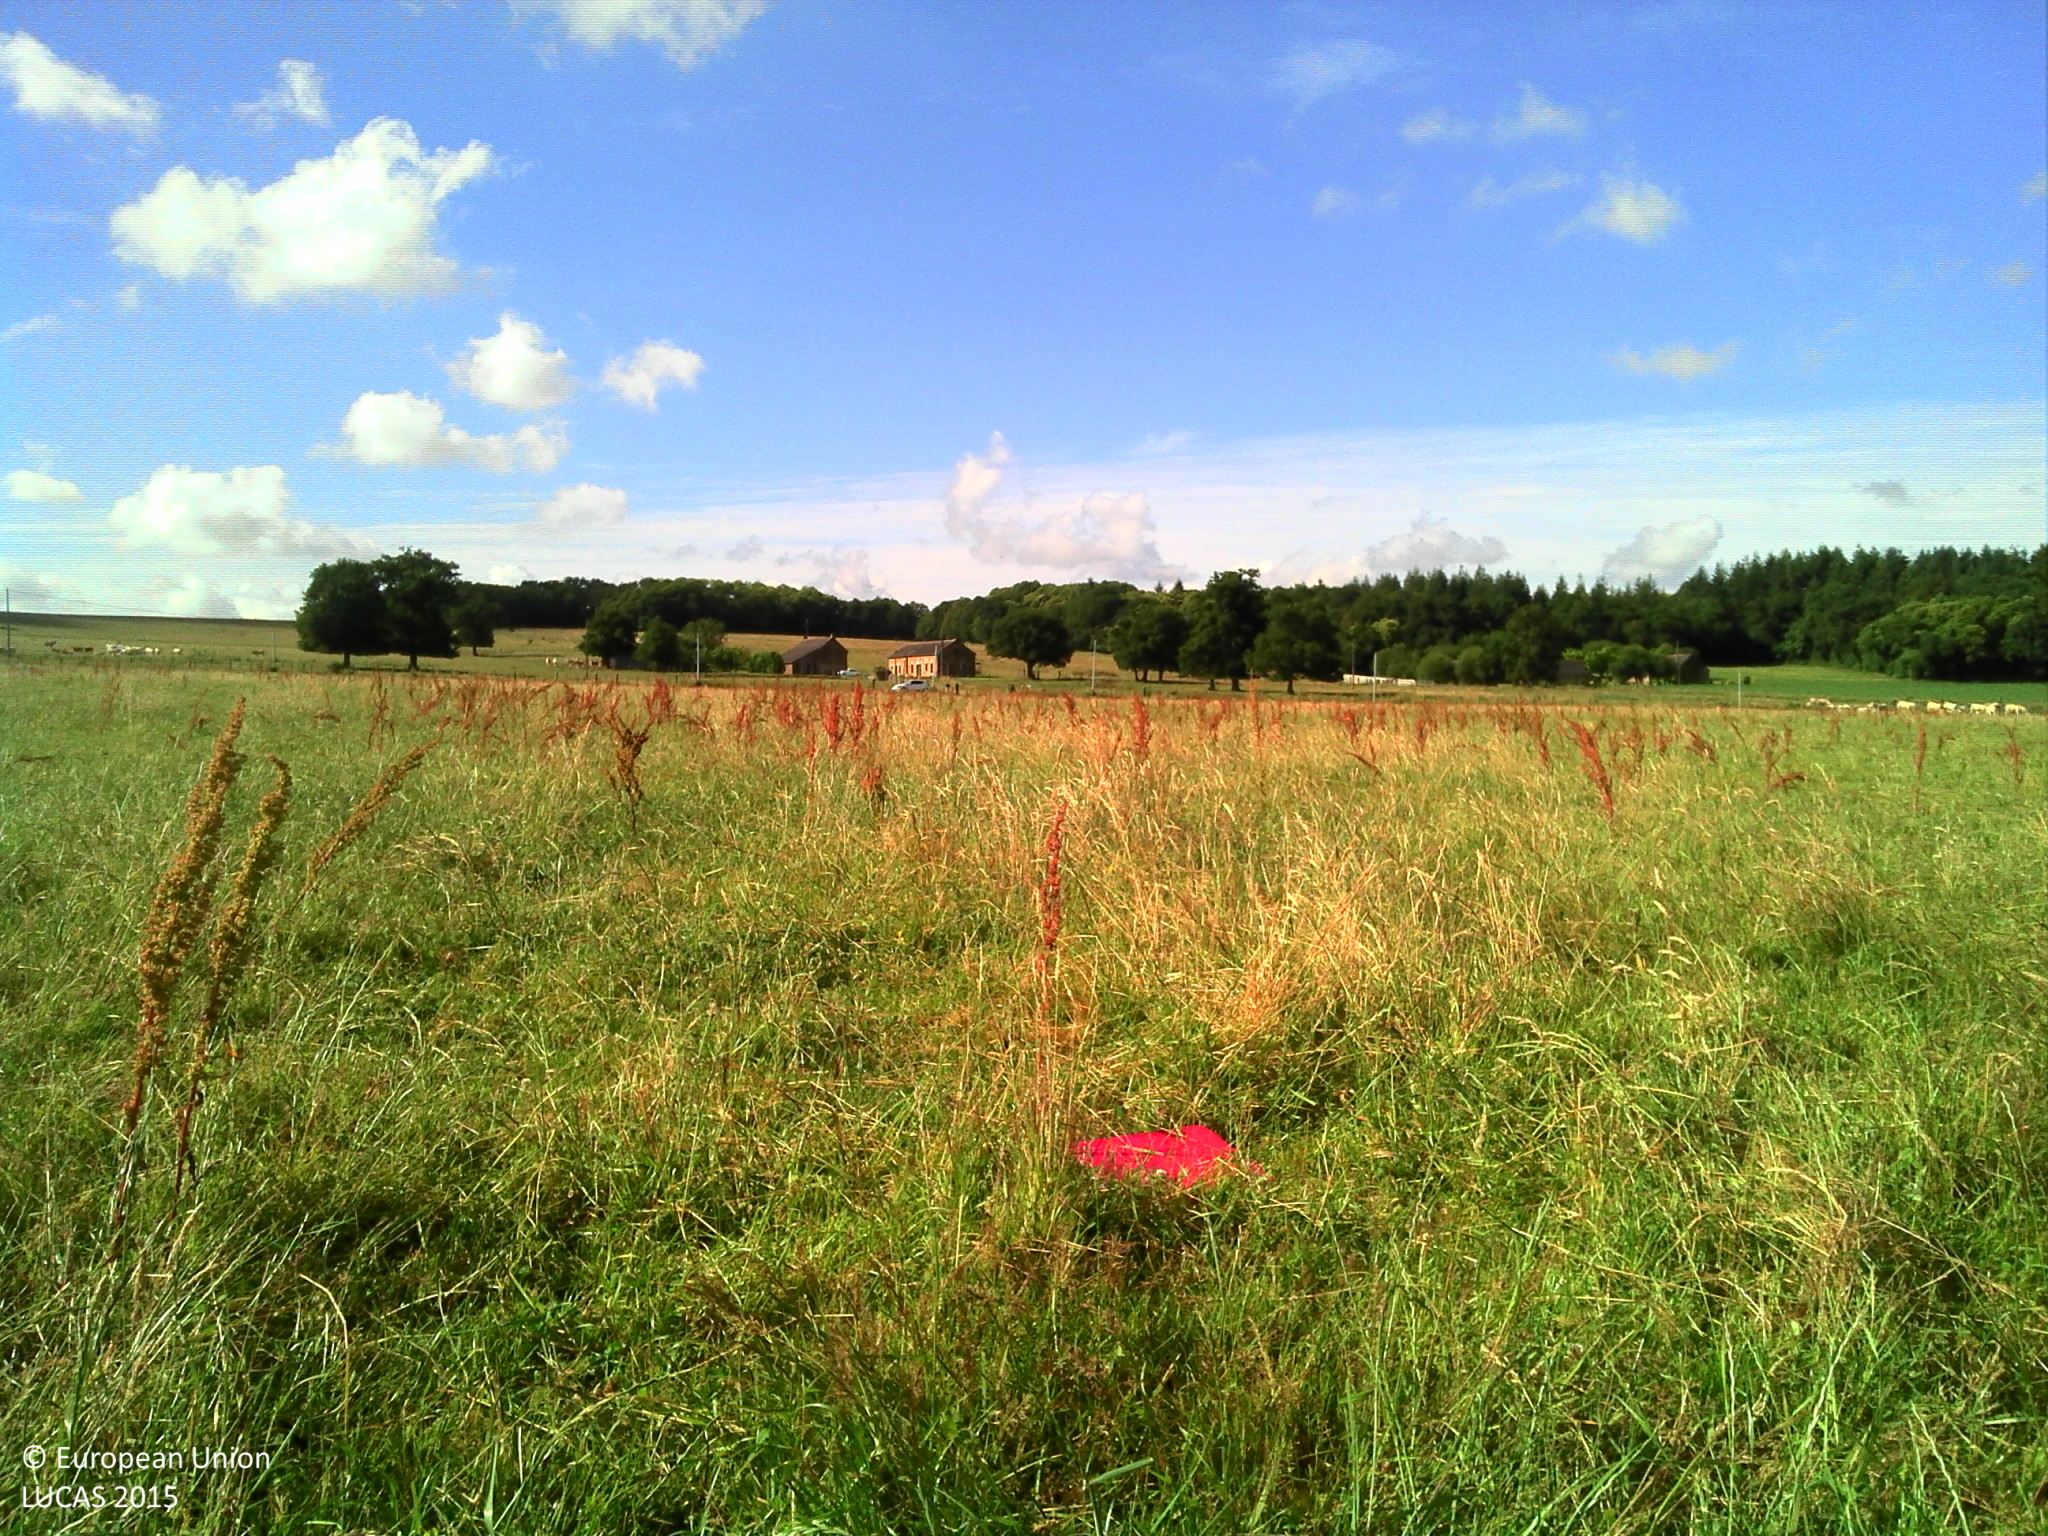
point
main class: Grassland
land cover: Grassland without tree/shrub cover
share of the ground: > 75 %
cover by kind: herbaceous plants 100 %
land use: Agriculture (excluding fallow land and kitchen gardens)
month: June
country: FR
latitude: 47.8007
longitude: -1.6756
